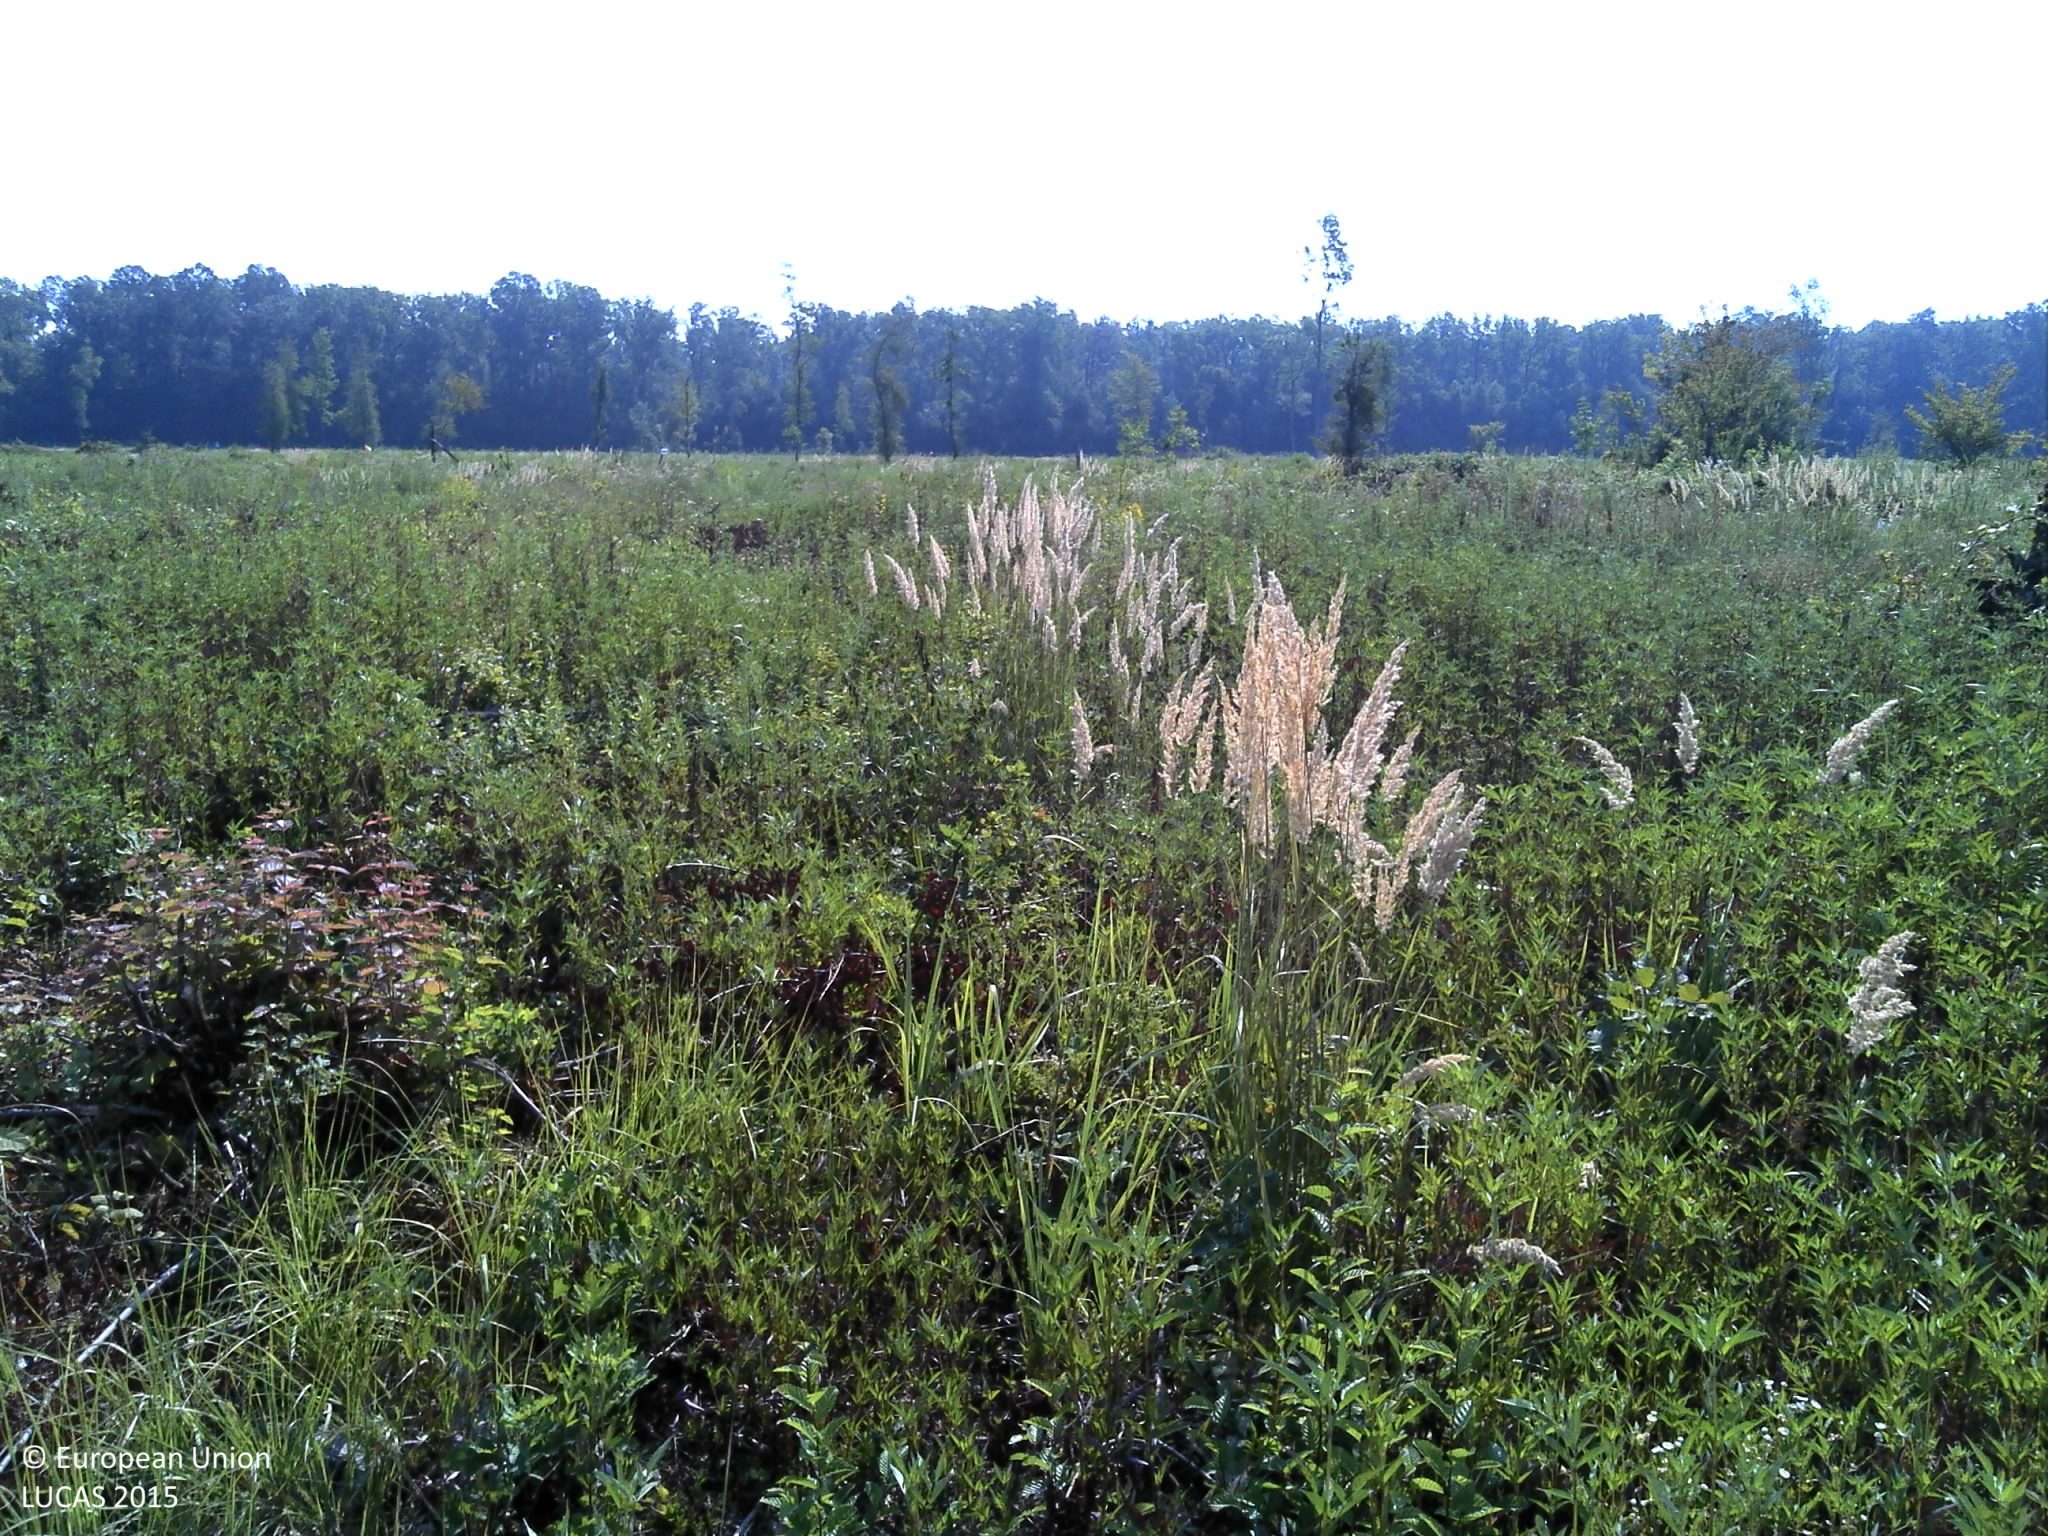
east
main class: Grassland
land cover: Spontaneously vegetated surfaces
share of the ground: > 75 %
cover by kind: herbaceous plants 100 %
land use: Semi-natural and natural areas not in use
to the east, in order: Spontaneously vegetated surfaces
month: August
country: HR
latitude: 45.0990
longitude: 18.8129
